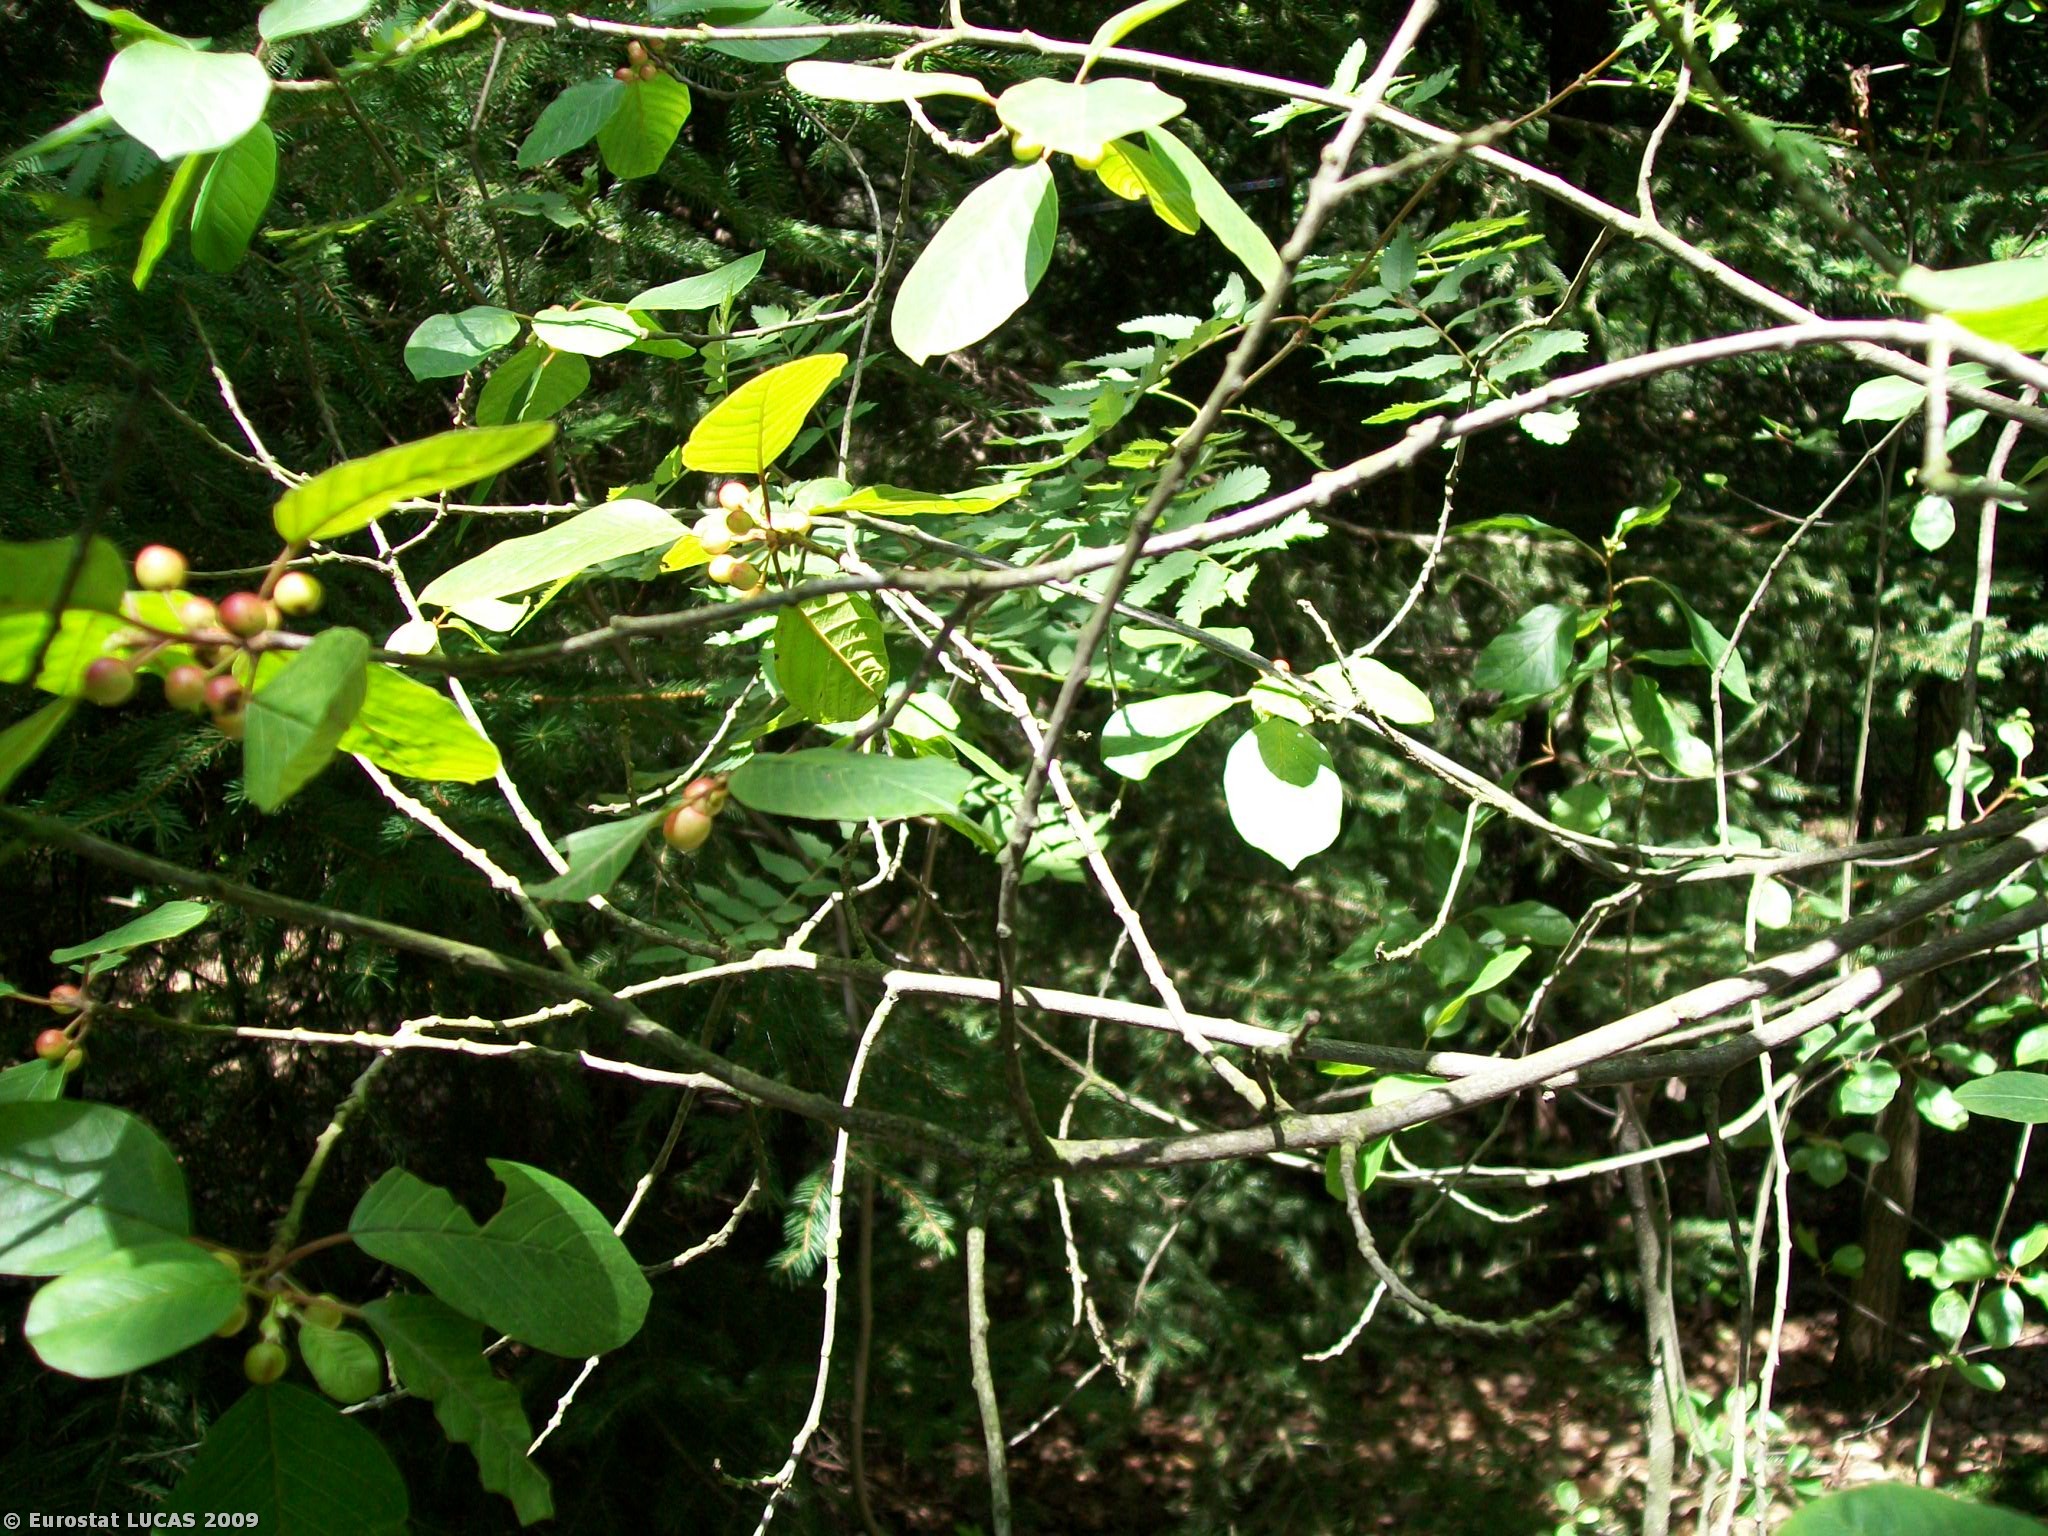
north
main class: Woodland
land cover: Coniferous woodland
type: hemiboreal forest and nemoral coniferous forest and mixed broadleaved-coniferous forest
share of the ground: > 75 %
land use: Unused
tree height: > 5 m
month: July
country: PL
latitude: 51.1736
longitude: 16.7745
